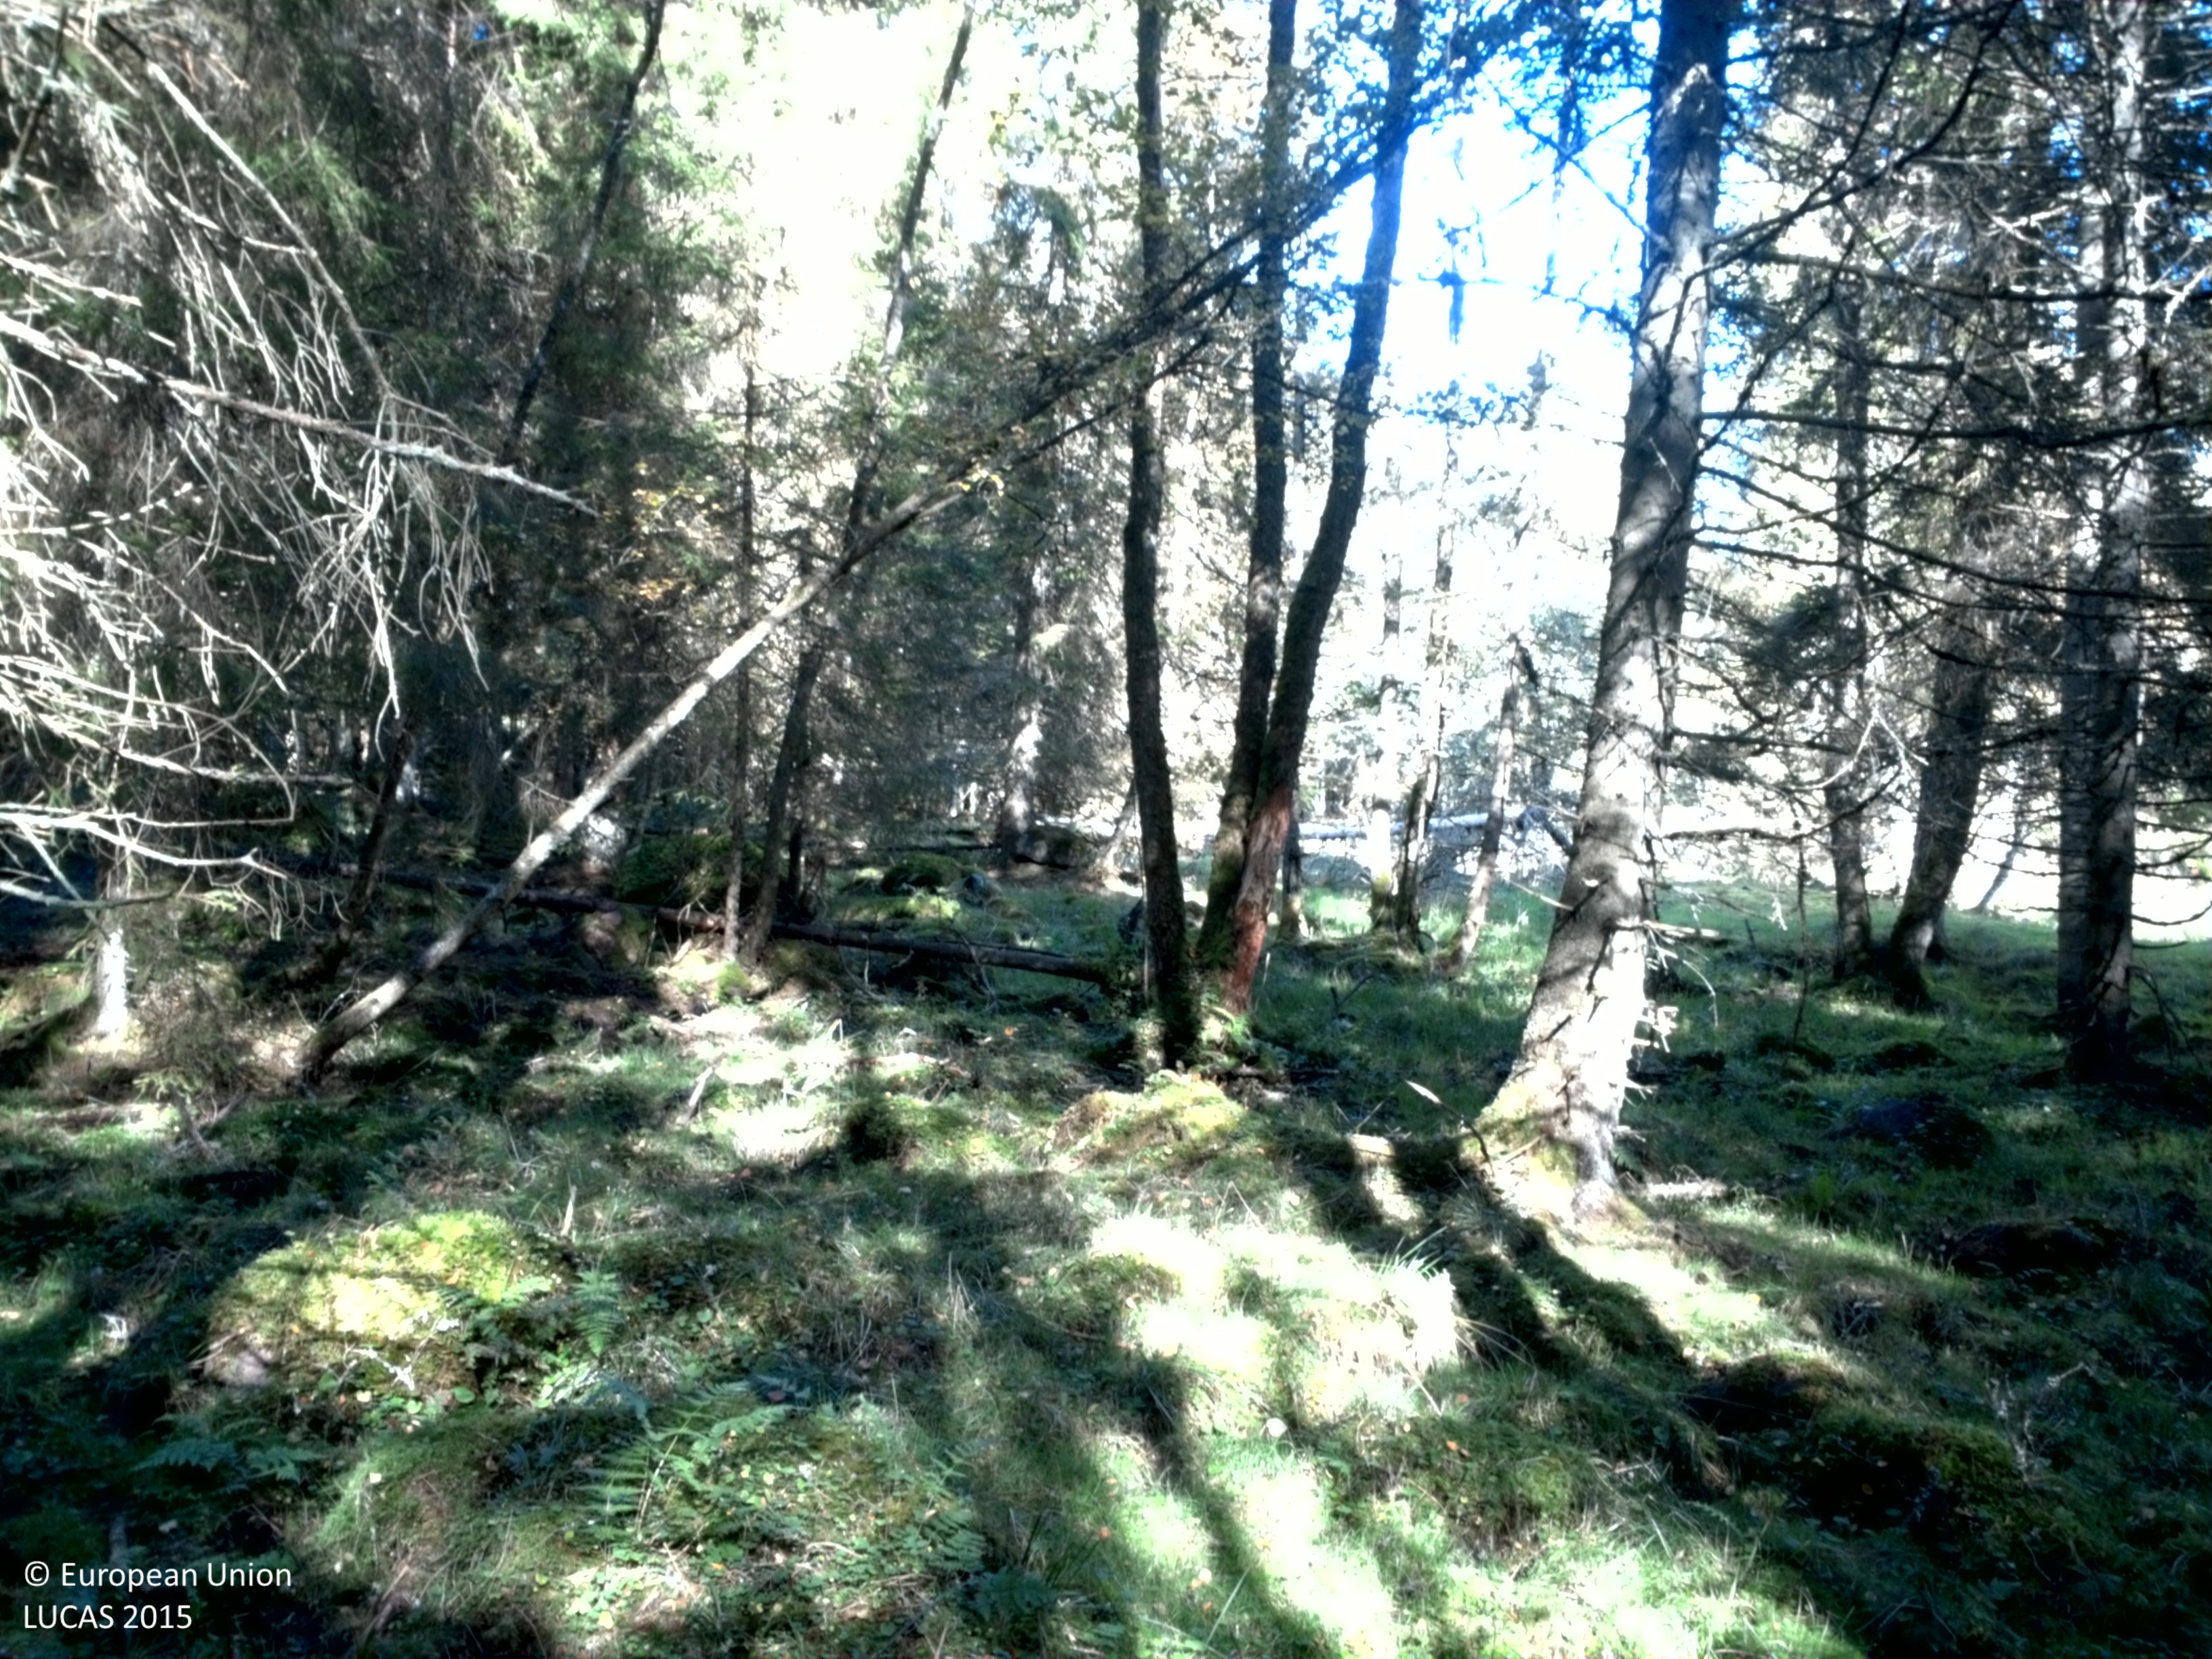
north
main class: Woodland
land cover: Spruce dominated mixed woodland
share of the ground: 50 - 75 %
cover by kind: coniferous forest trees 40 %, lichens and mosses 30 %, broadleaved forest trees 25 %, herbaceous plants 5 %
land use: Forestry
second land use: Agriculture (excluding fallow land and kitchen gardens)
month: September
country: SE
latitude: 57.9461
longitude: 13.2555
